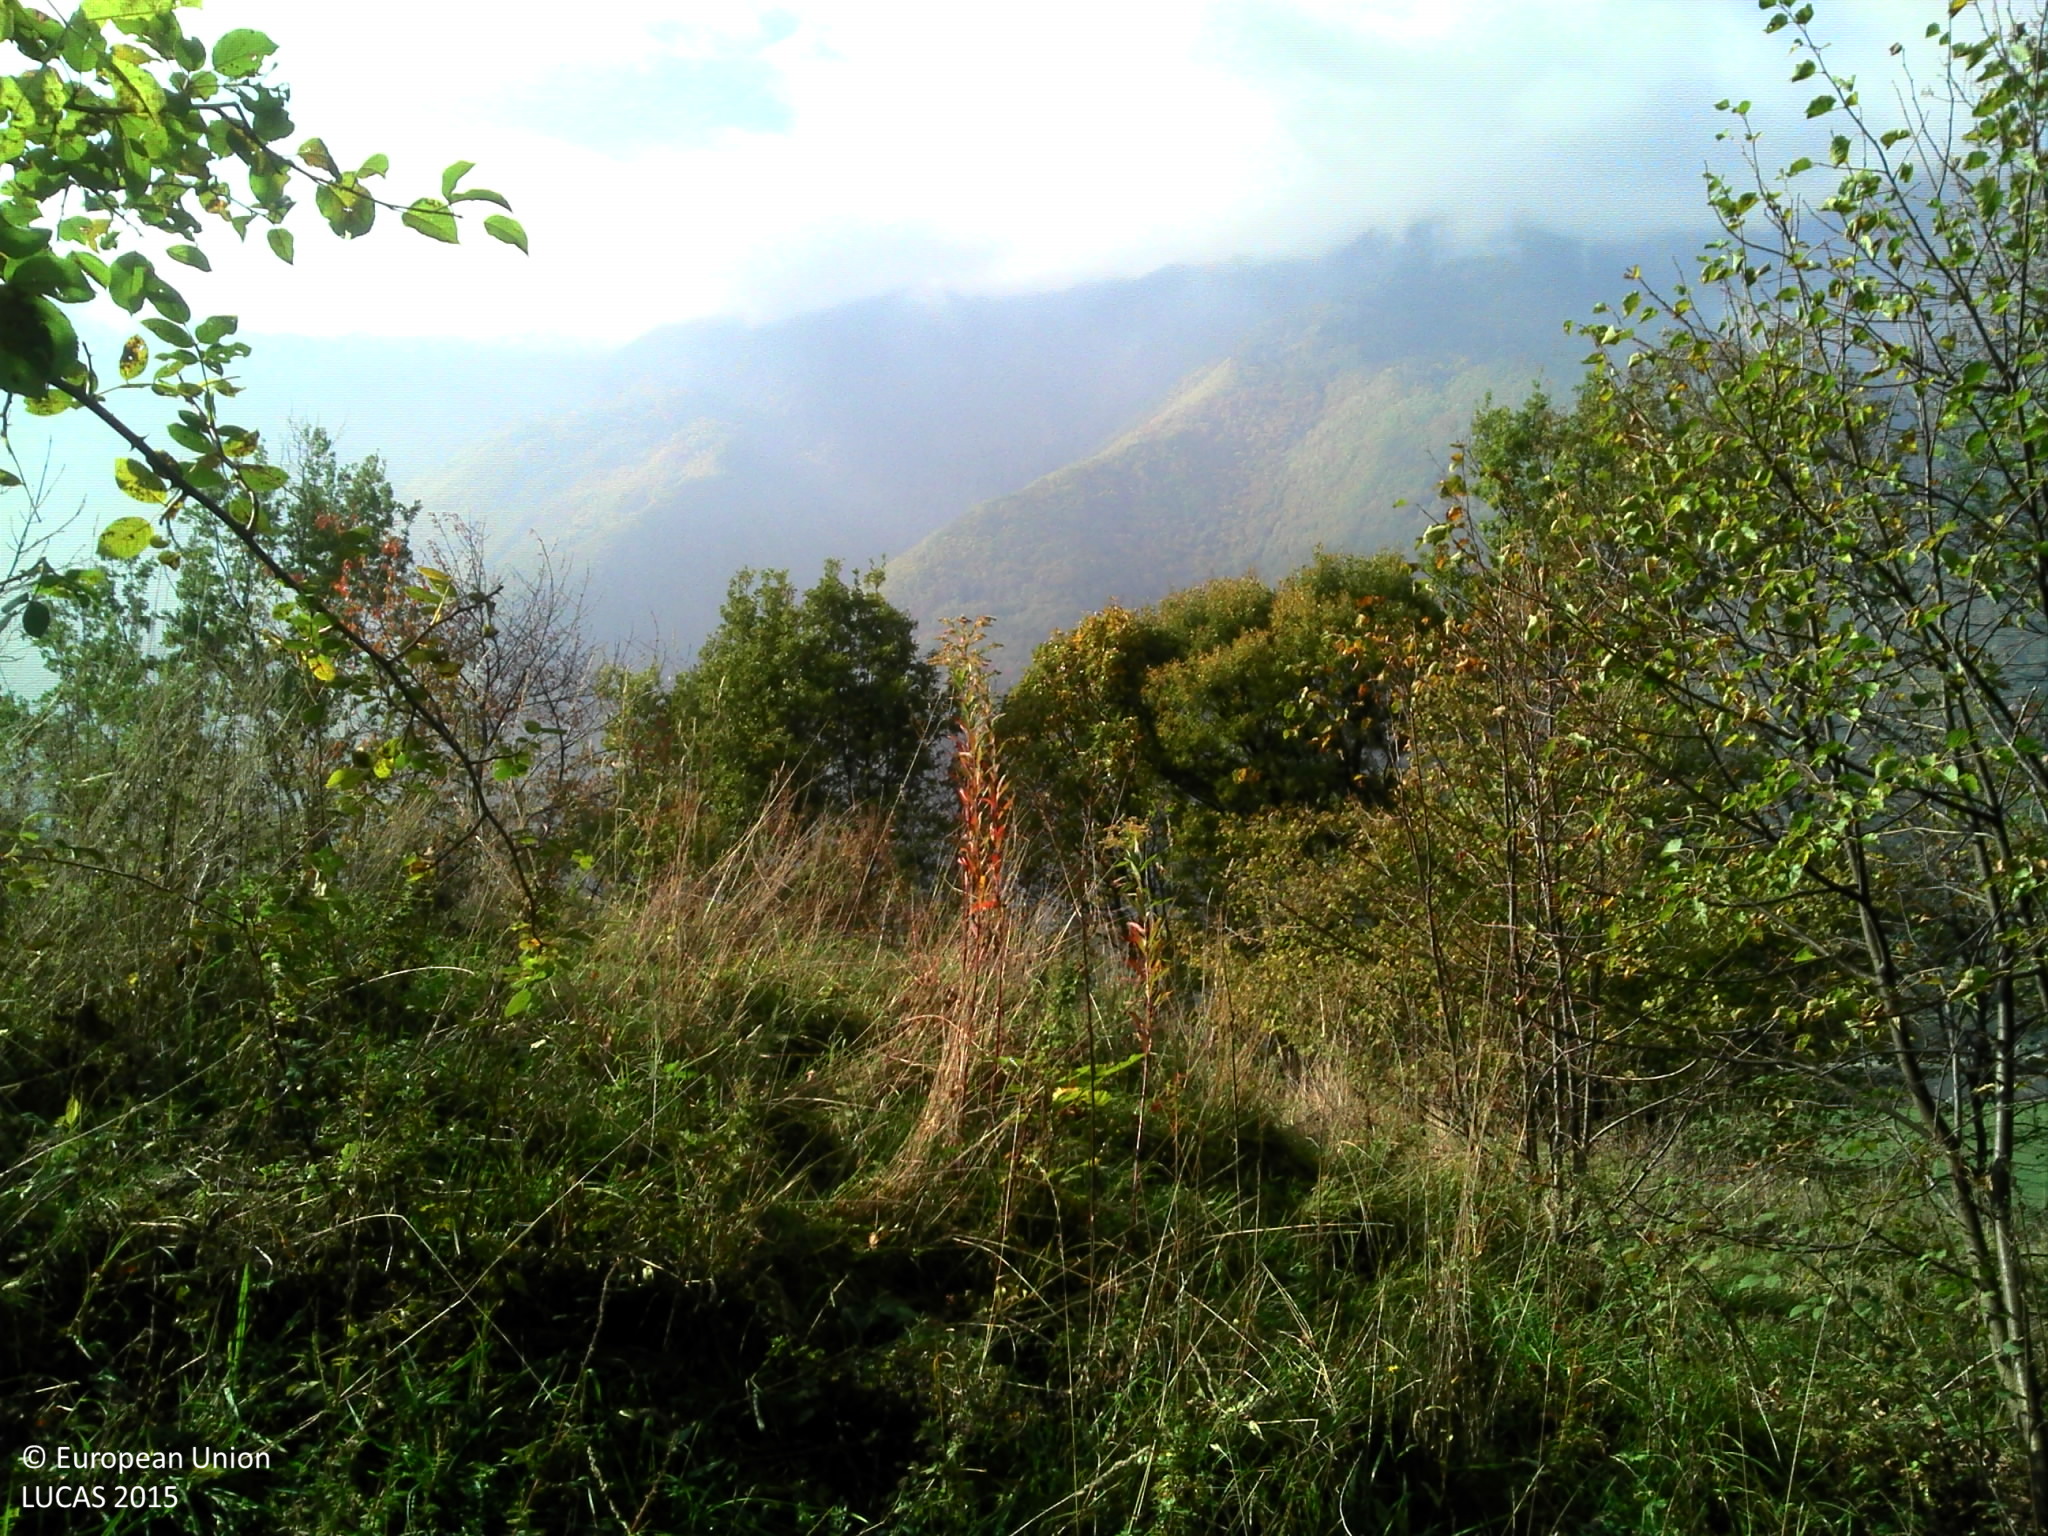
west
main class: Woodland
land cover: Broadleaved woodland
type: mesophytic deciduous forest
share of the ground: > 75 %
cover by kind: broadleaved forest trees 90 %, shrubs 5 %, consolidated bare surface 5 %
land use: Forestry
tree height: > 5 m
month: October
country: FR
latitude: 45.4031
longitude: 6.2871
